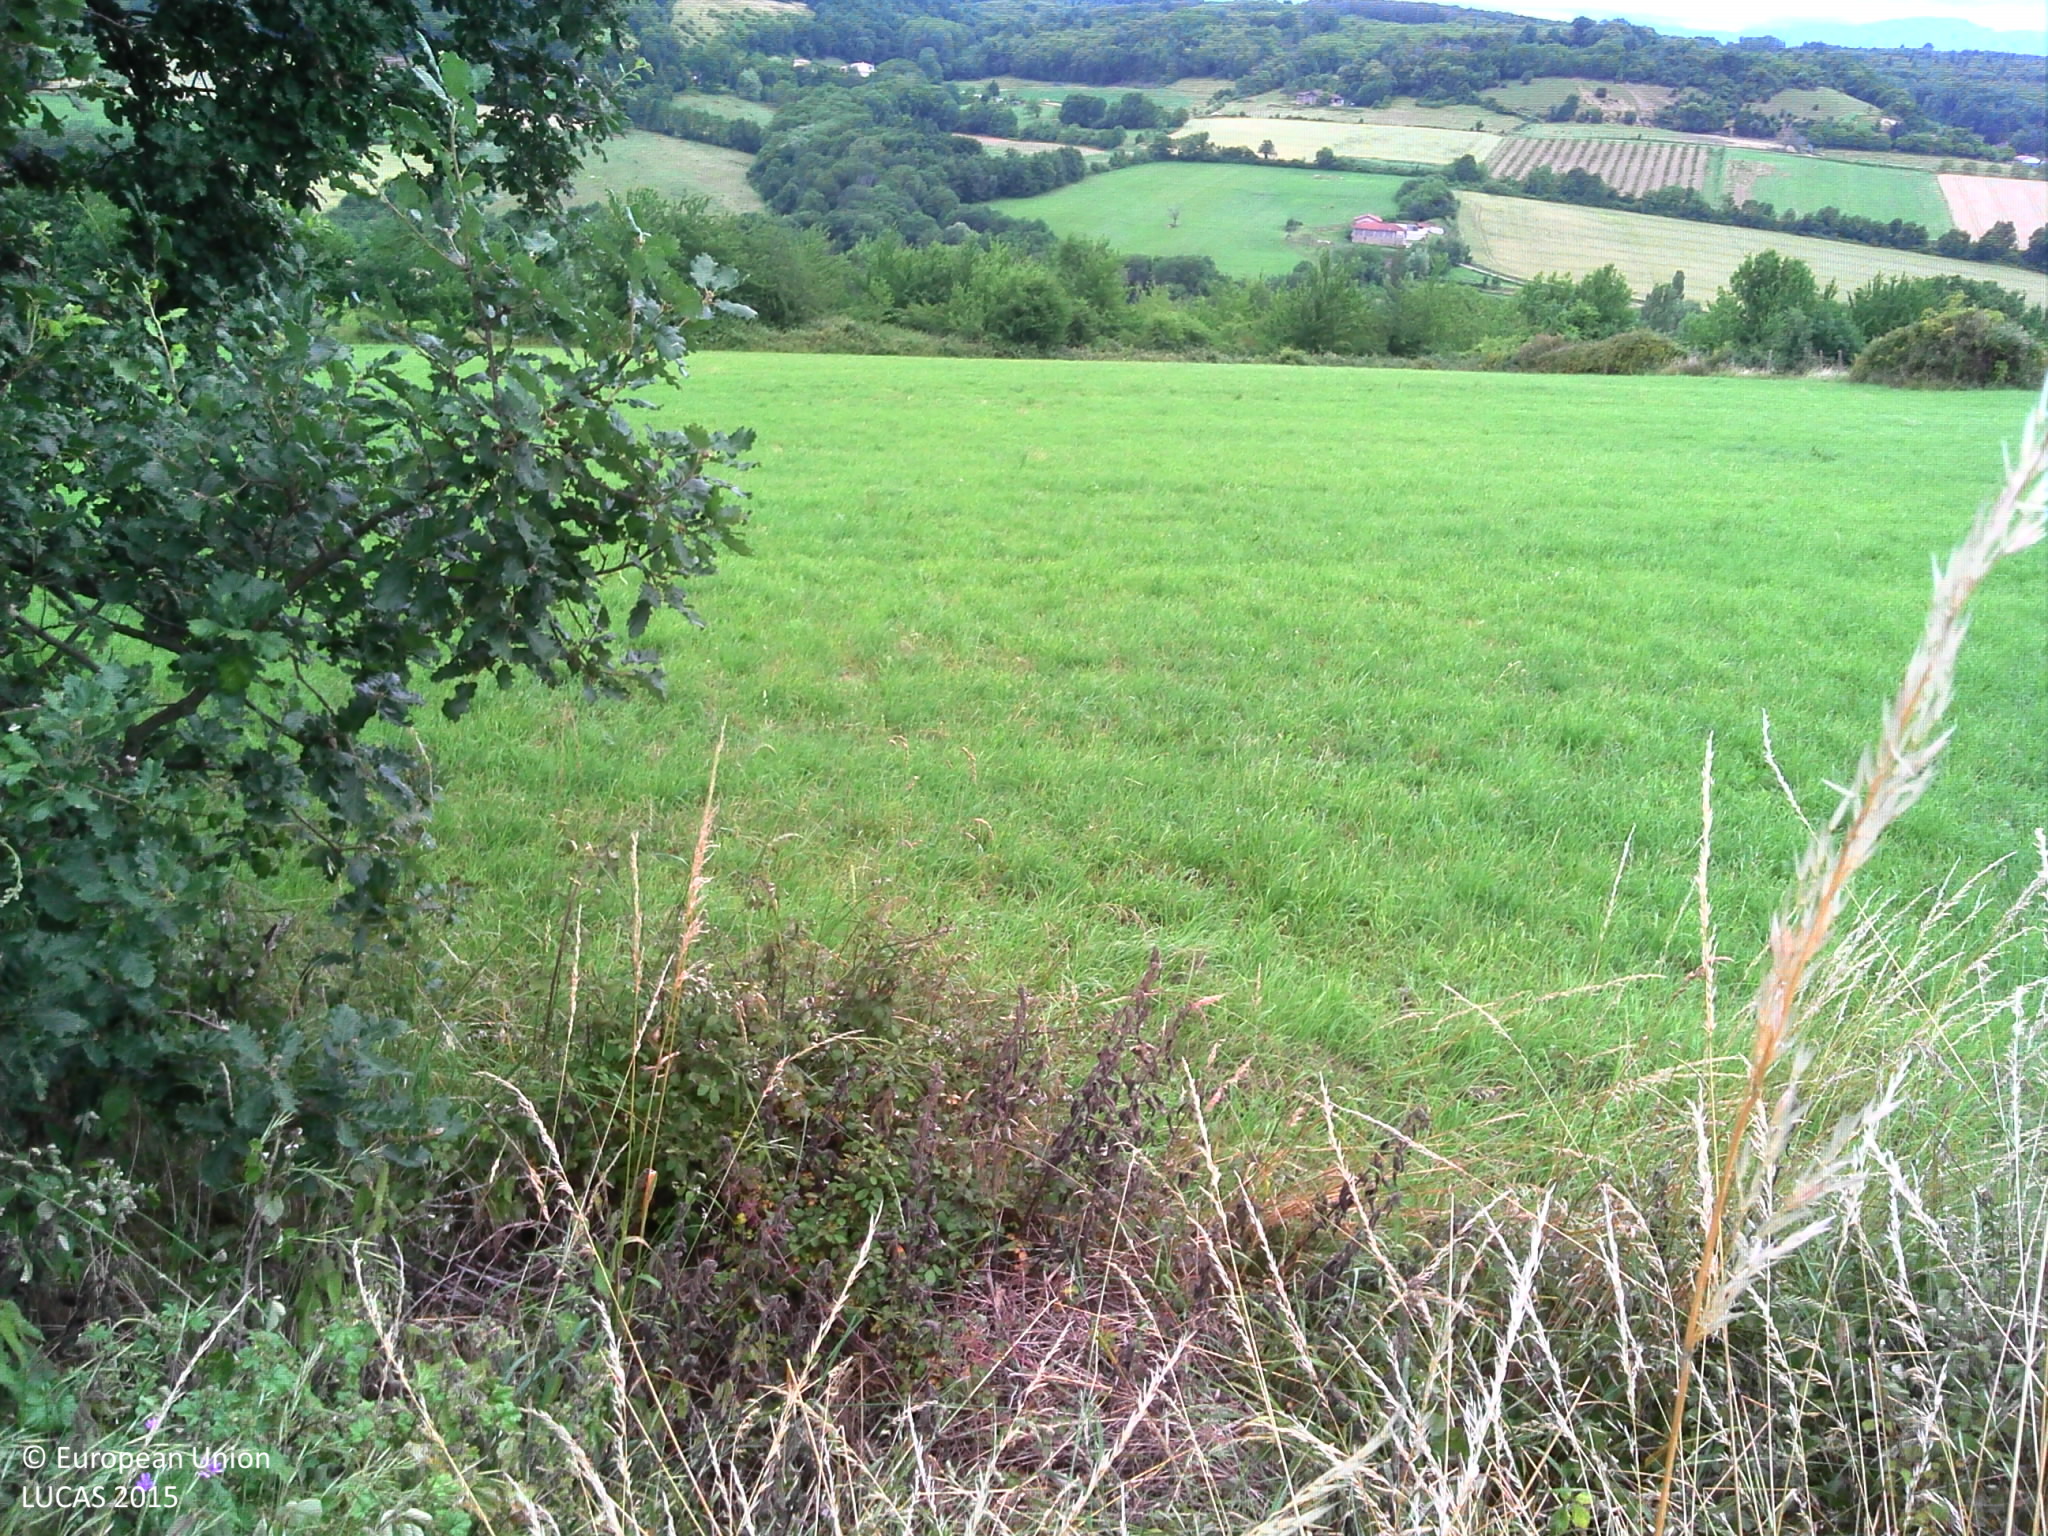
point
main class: Grassland
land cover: Grassland without tree/shrub cover
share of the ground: > 75 %
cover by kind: herbaceous plants 100 %
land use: Agriculture (excluding fallow land and kitchen gardens)
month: June
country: FR
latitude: 45.1551
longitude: 5.0825
